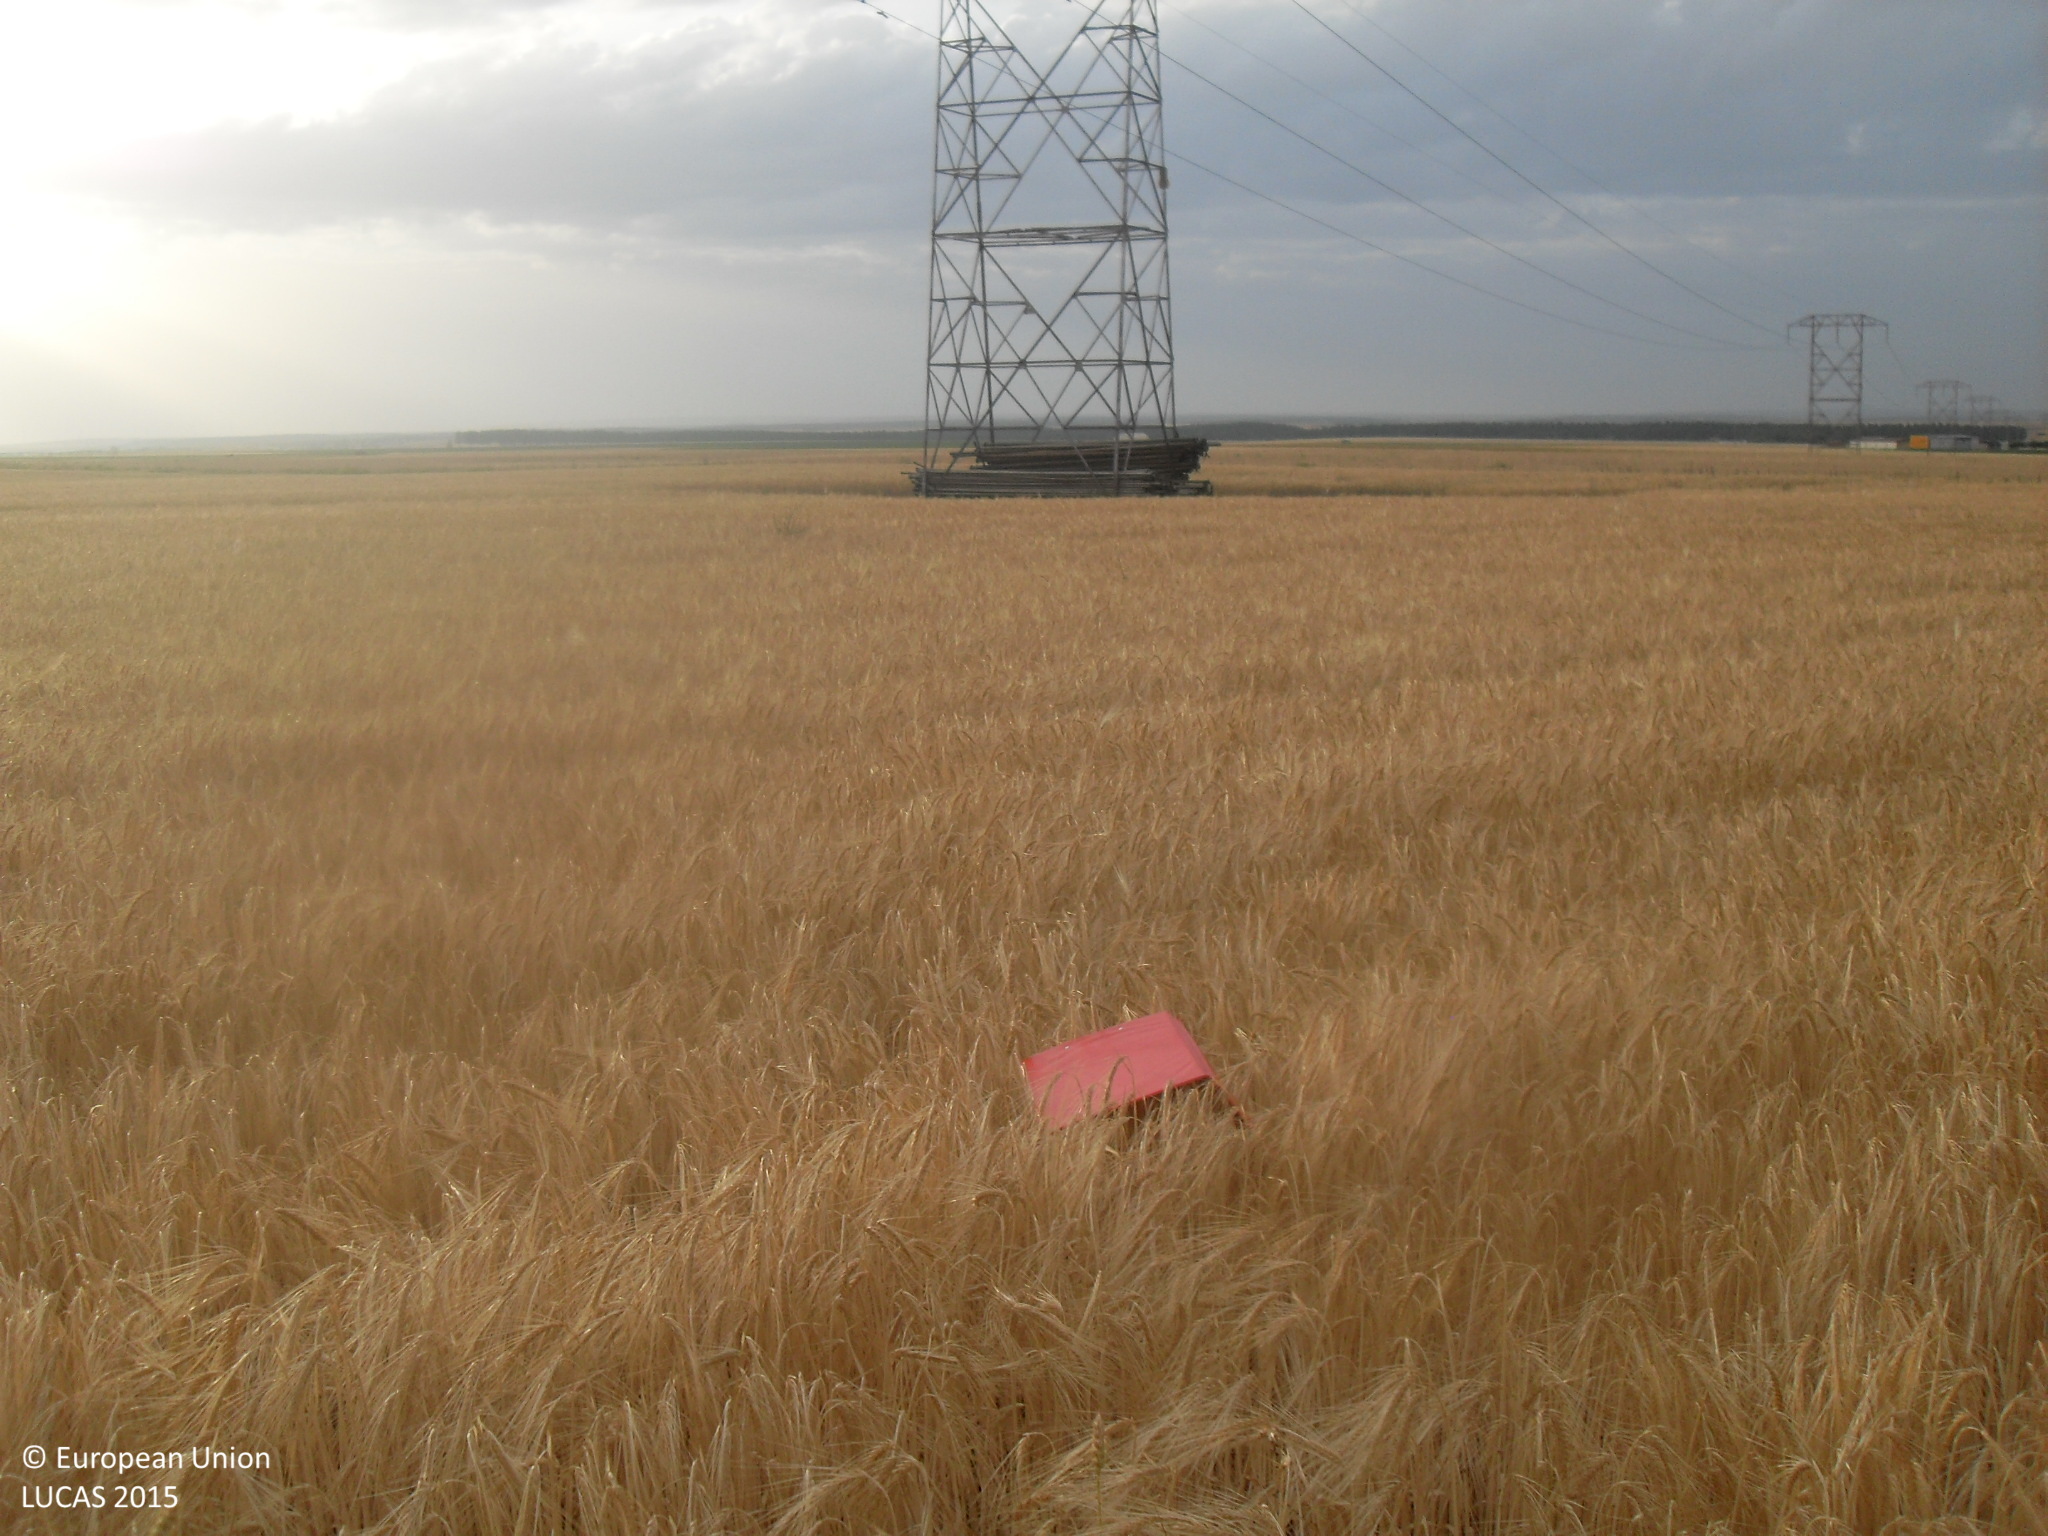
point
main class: Cropland
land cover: Barley
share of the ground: > 75 %
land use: Agriculture (excluding fallow land and kitchen gardens)
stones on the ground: 10 - 25 %
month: June
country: ES
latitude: 41.0708
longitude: -5.7059
